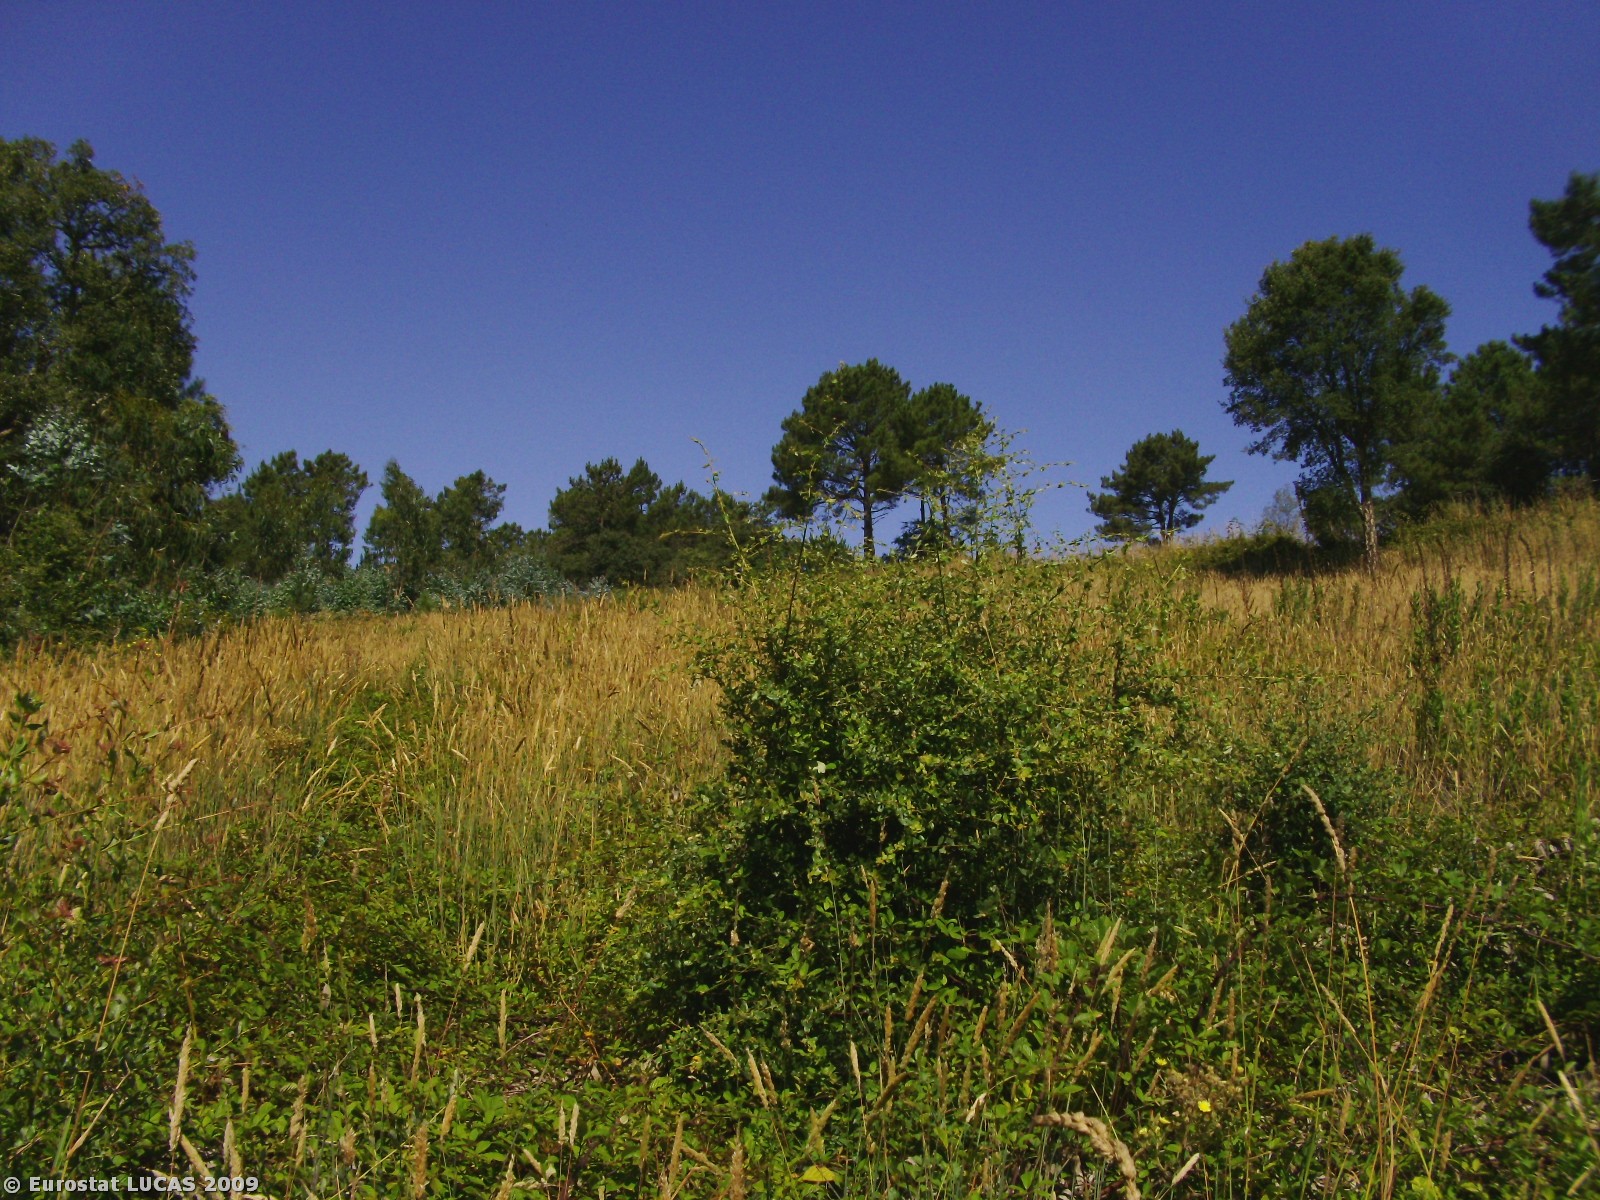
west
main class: Grassland
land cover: Spontaneously vegetated surfaces
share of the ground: > 75 %
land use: Fallow land
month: July
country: PT
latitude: 38.9258
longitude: -9.2890
